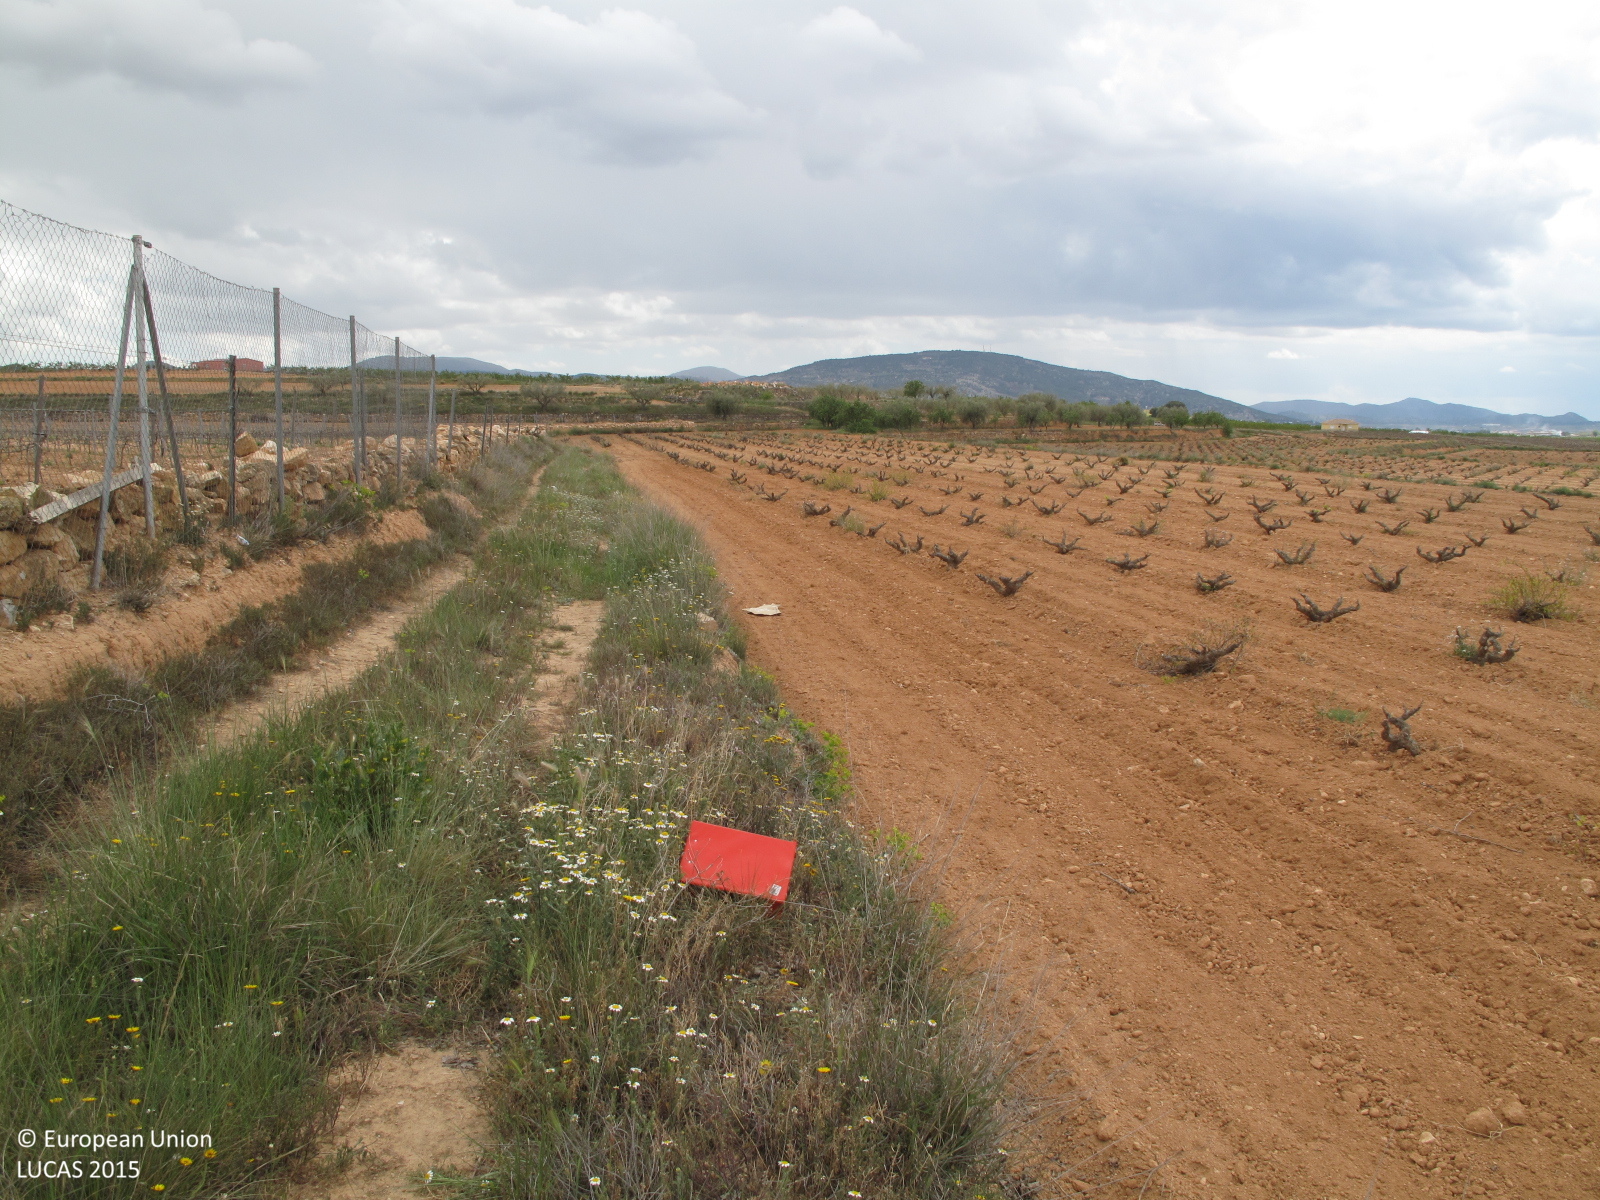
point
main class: Cropland
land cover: Vineyards
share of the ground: < 10 %
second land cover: Other bare soil
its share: > 75 %
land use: Agriculture (excluding fallow land and kitchen gardens)
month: April
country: ES
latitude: 38.4367
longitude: -1.0442
